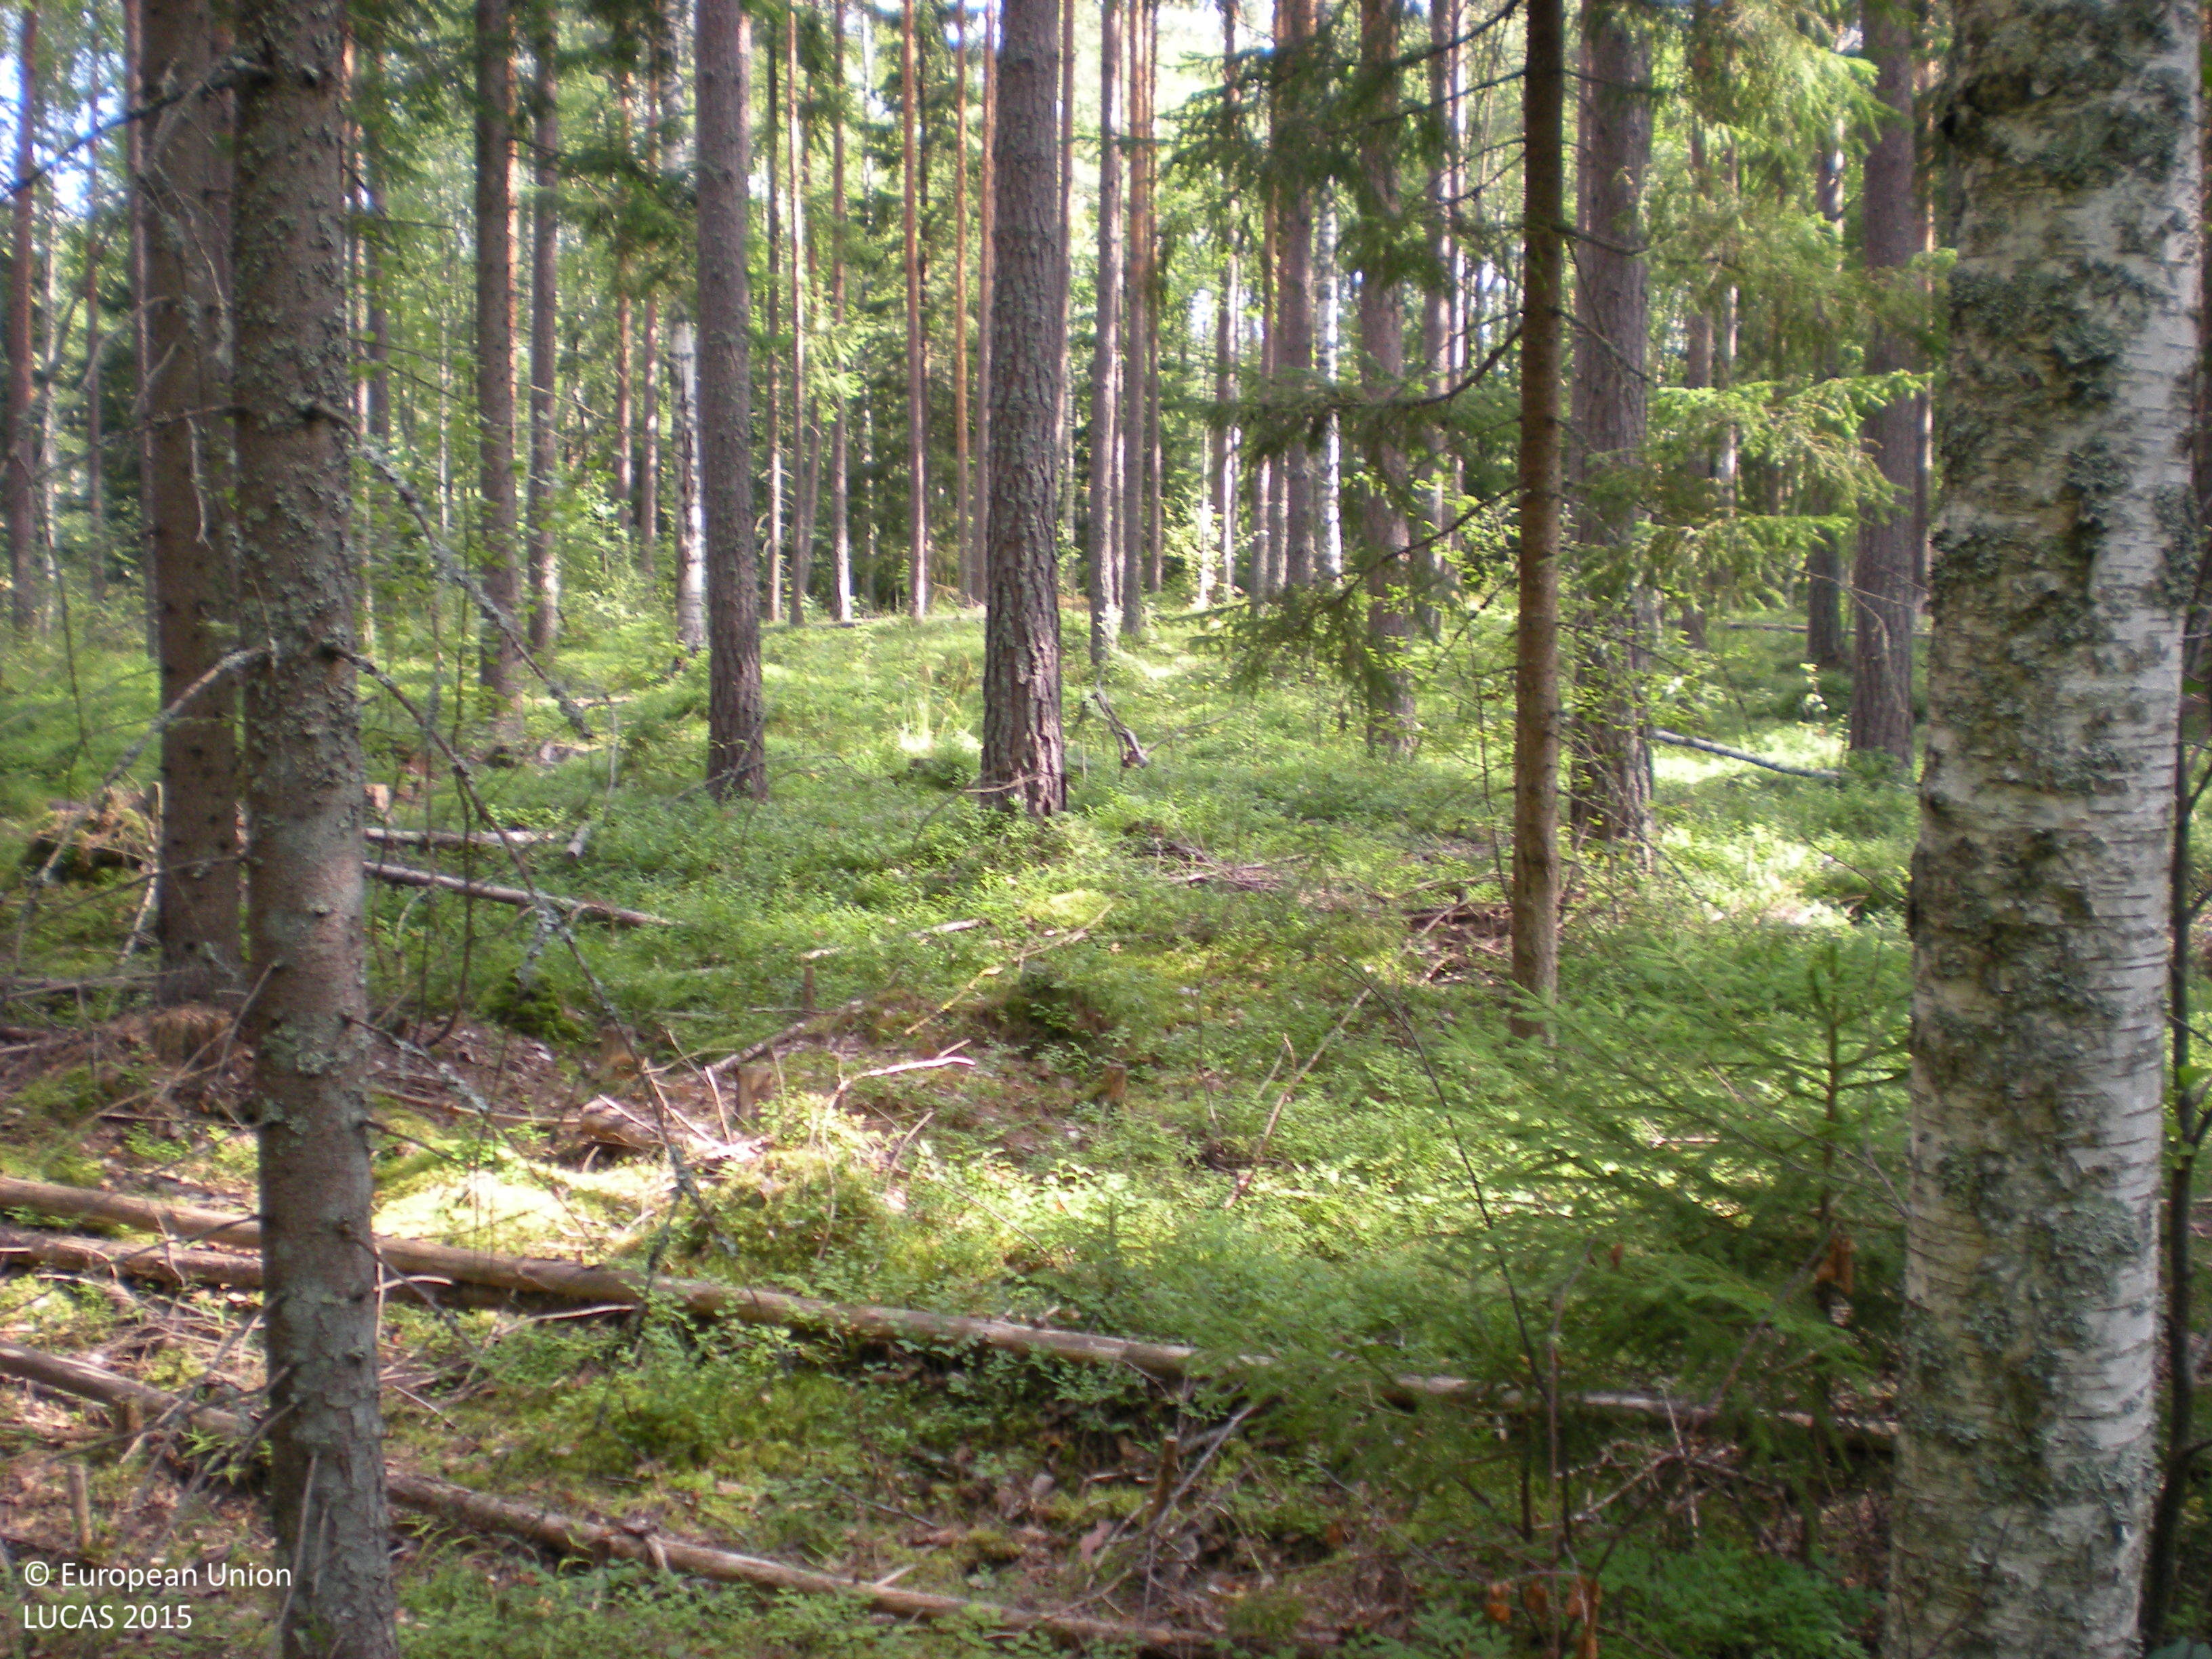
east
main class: Woodland
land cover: Spruce dominated mixed woodland
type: boreal forest
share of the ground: 50 - 75 %
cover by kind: coniferous forest trees 50 %, broadleaved forest trees 20 %, shrubs 20 %, herbaceous plants 5 %, lichens and mosses 5 %
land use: Forestry
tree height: > 5 m
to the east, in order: Spruce dominated mixed woodland; Pine dominated coniferous woodland; Spruce dominated mixed woodland; Ditches and canals; Spruce dominated mixed woodland; Other mixed woodland; Broadleaved woodland; Electric lines; Broadleaved woodland; Electric lines; Broadleaved woodland; Other coniferous woodland; Other mixed woodland
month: August
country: SE
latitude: 60.4646
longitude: 17.2464
